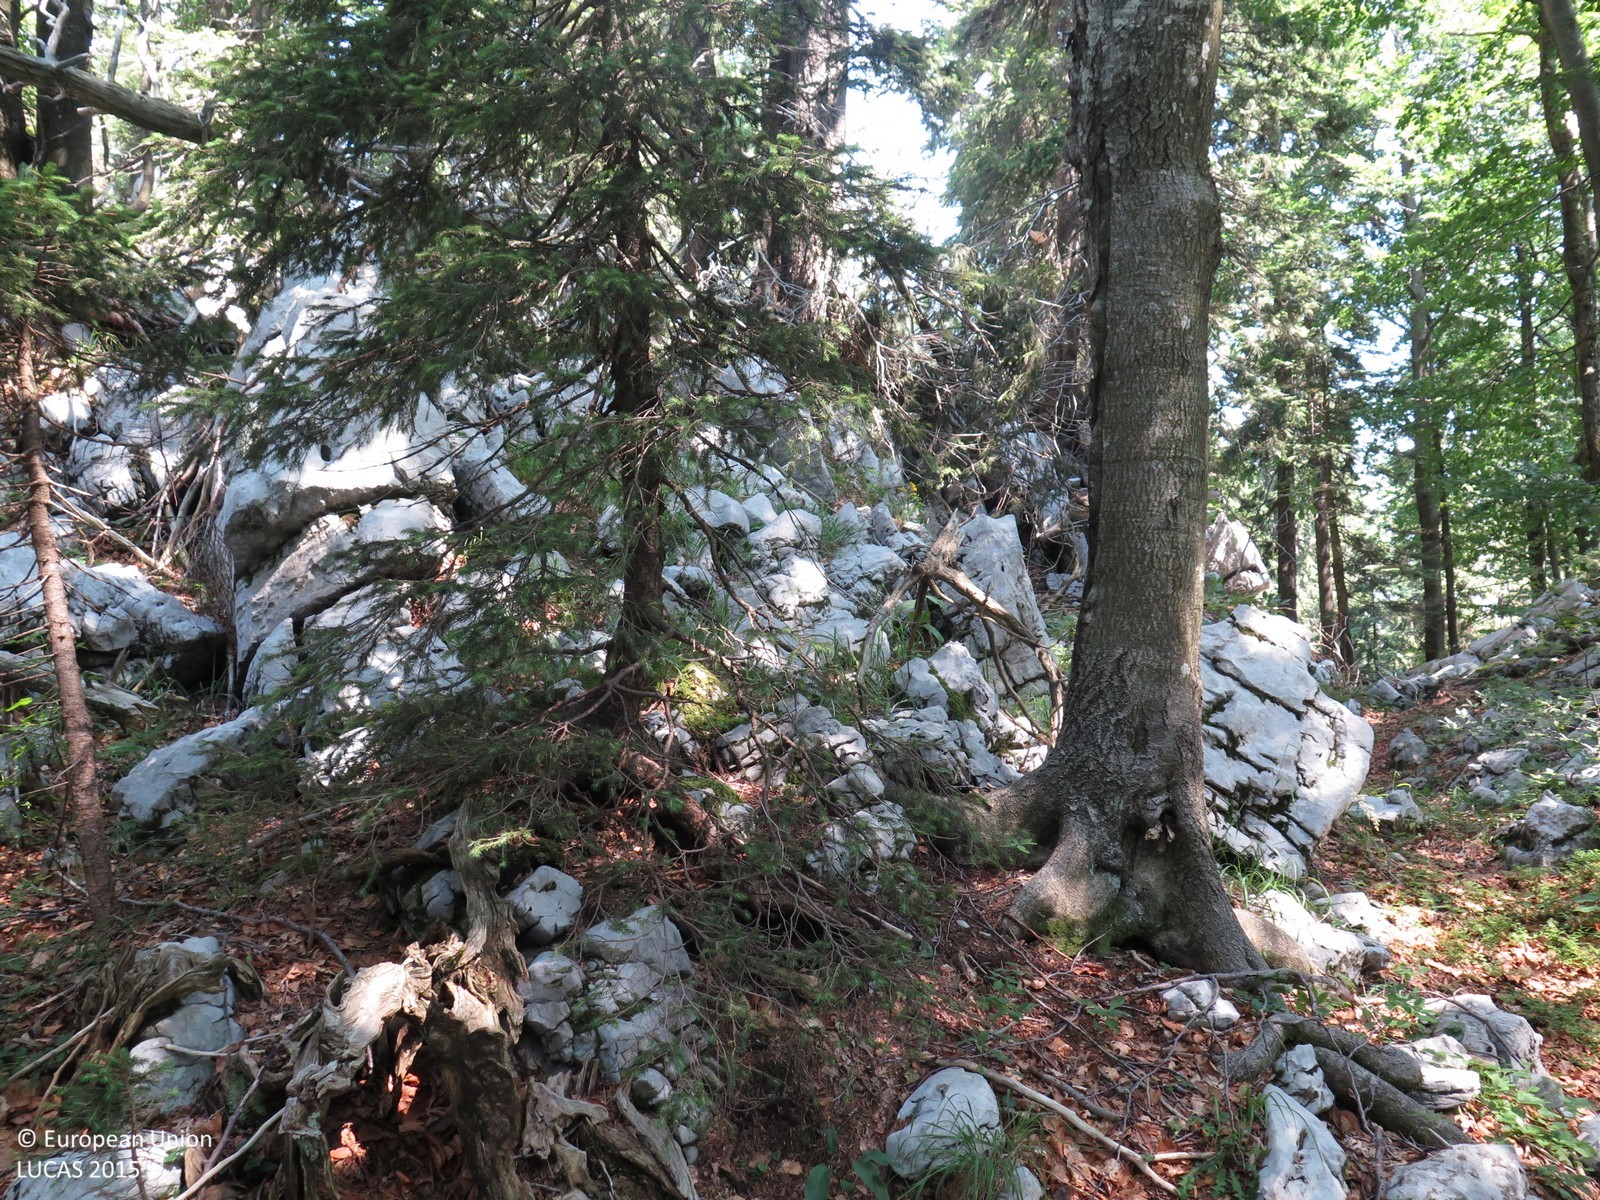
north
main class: Woodland
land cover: Other mixed woodland
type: mountainous beech forest
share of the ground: > 75 %
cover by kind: coniferous forest trees 65 %, broadleaved forest trees 25 %, consolidated bare surface 10 %
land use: Forestry
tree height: > 5 m
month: August
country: HR
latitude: 45.4971
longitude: 14.5383
